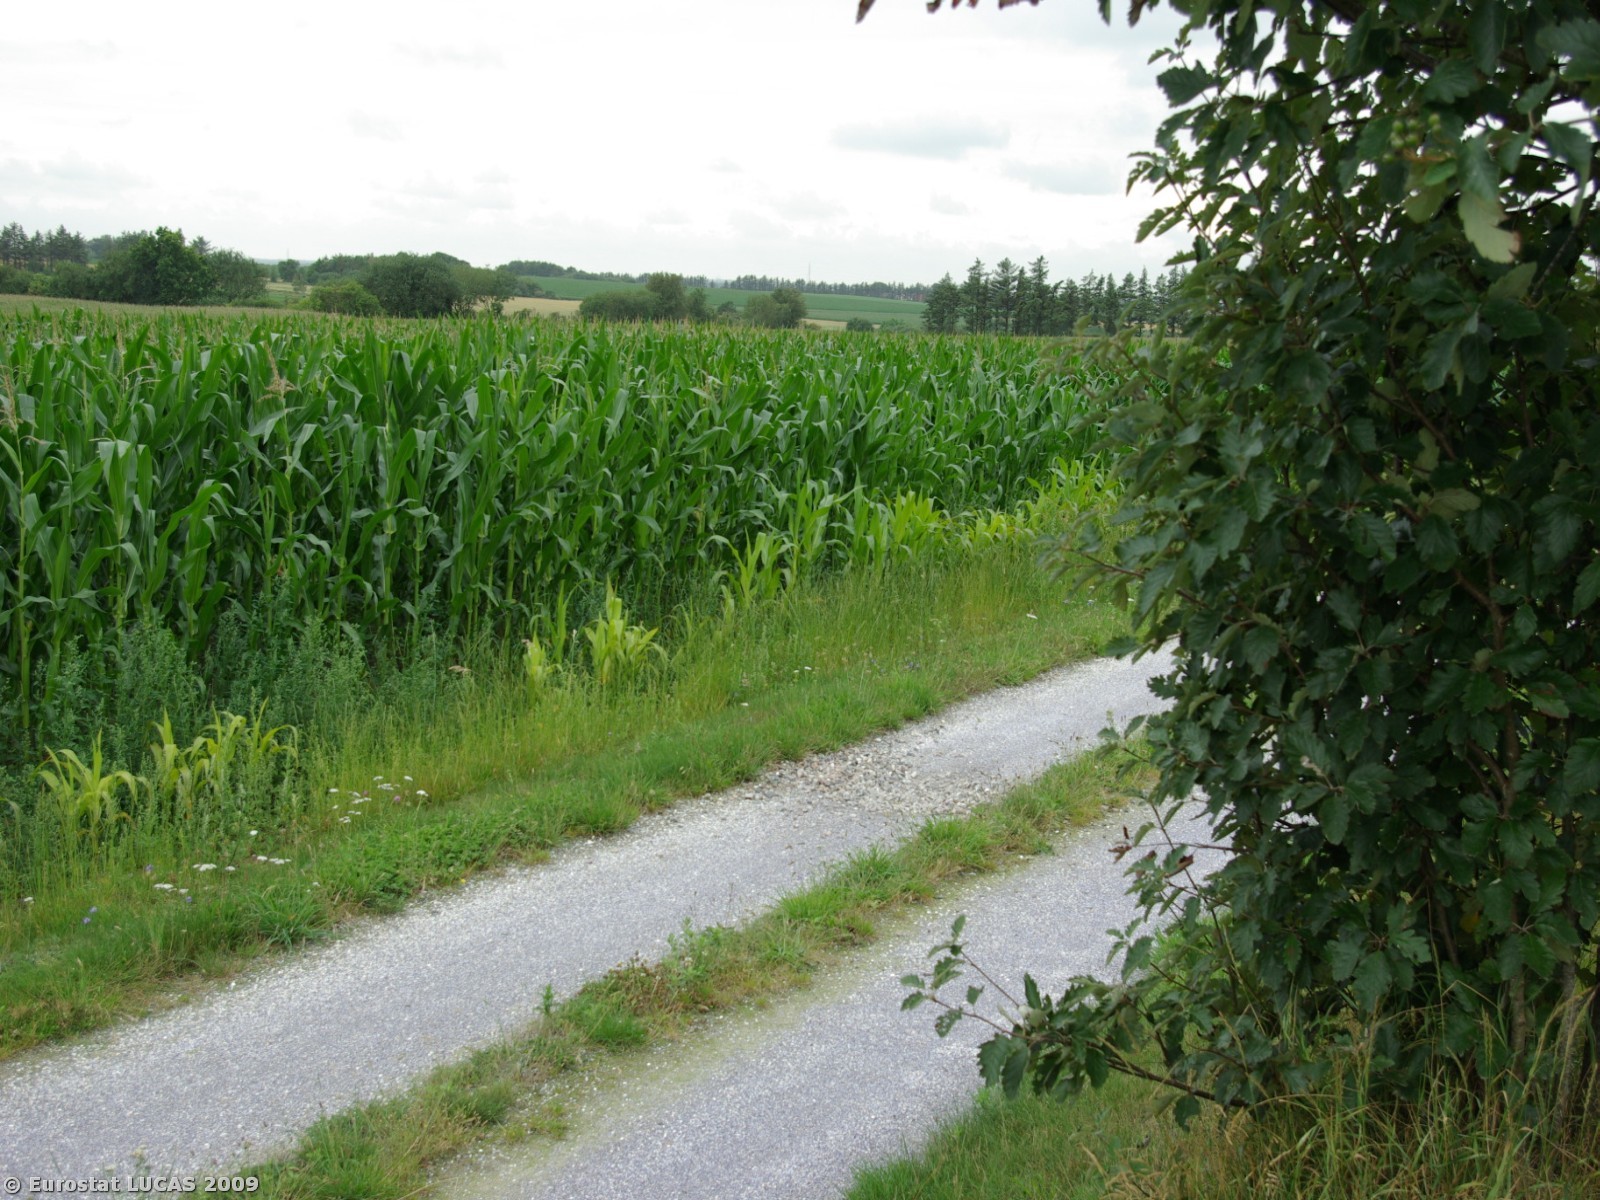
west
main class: Cropland
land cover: Maize
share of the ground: > 75 %
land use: Agriculture (excluding fallow land and kitchen gardens)
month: July
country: DK
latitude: 55.1223
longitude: 8.8876
